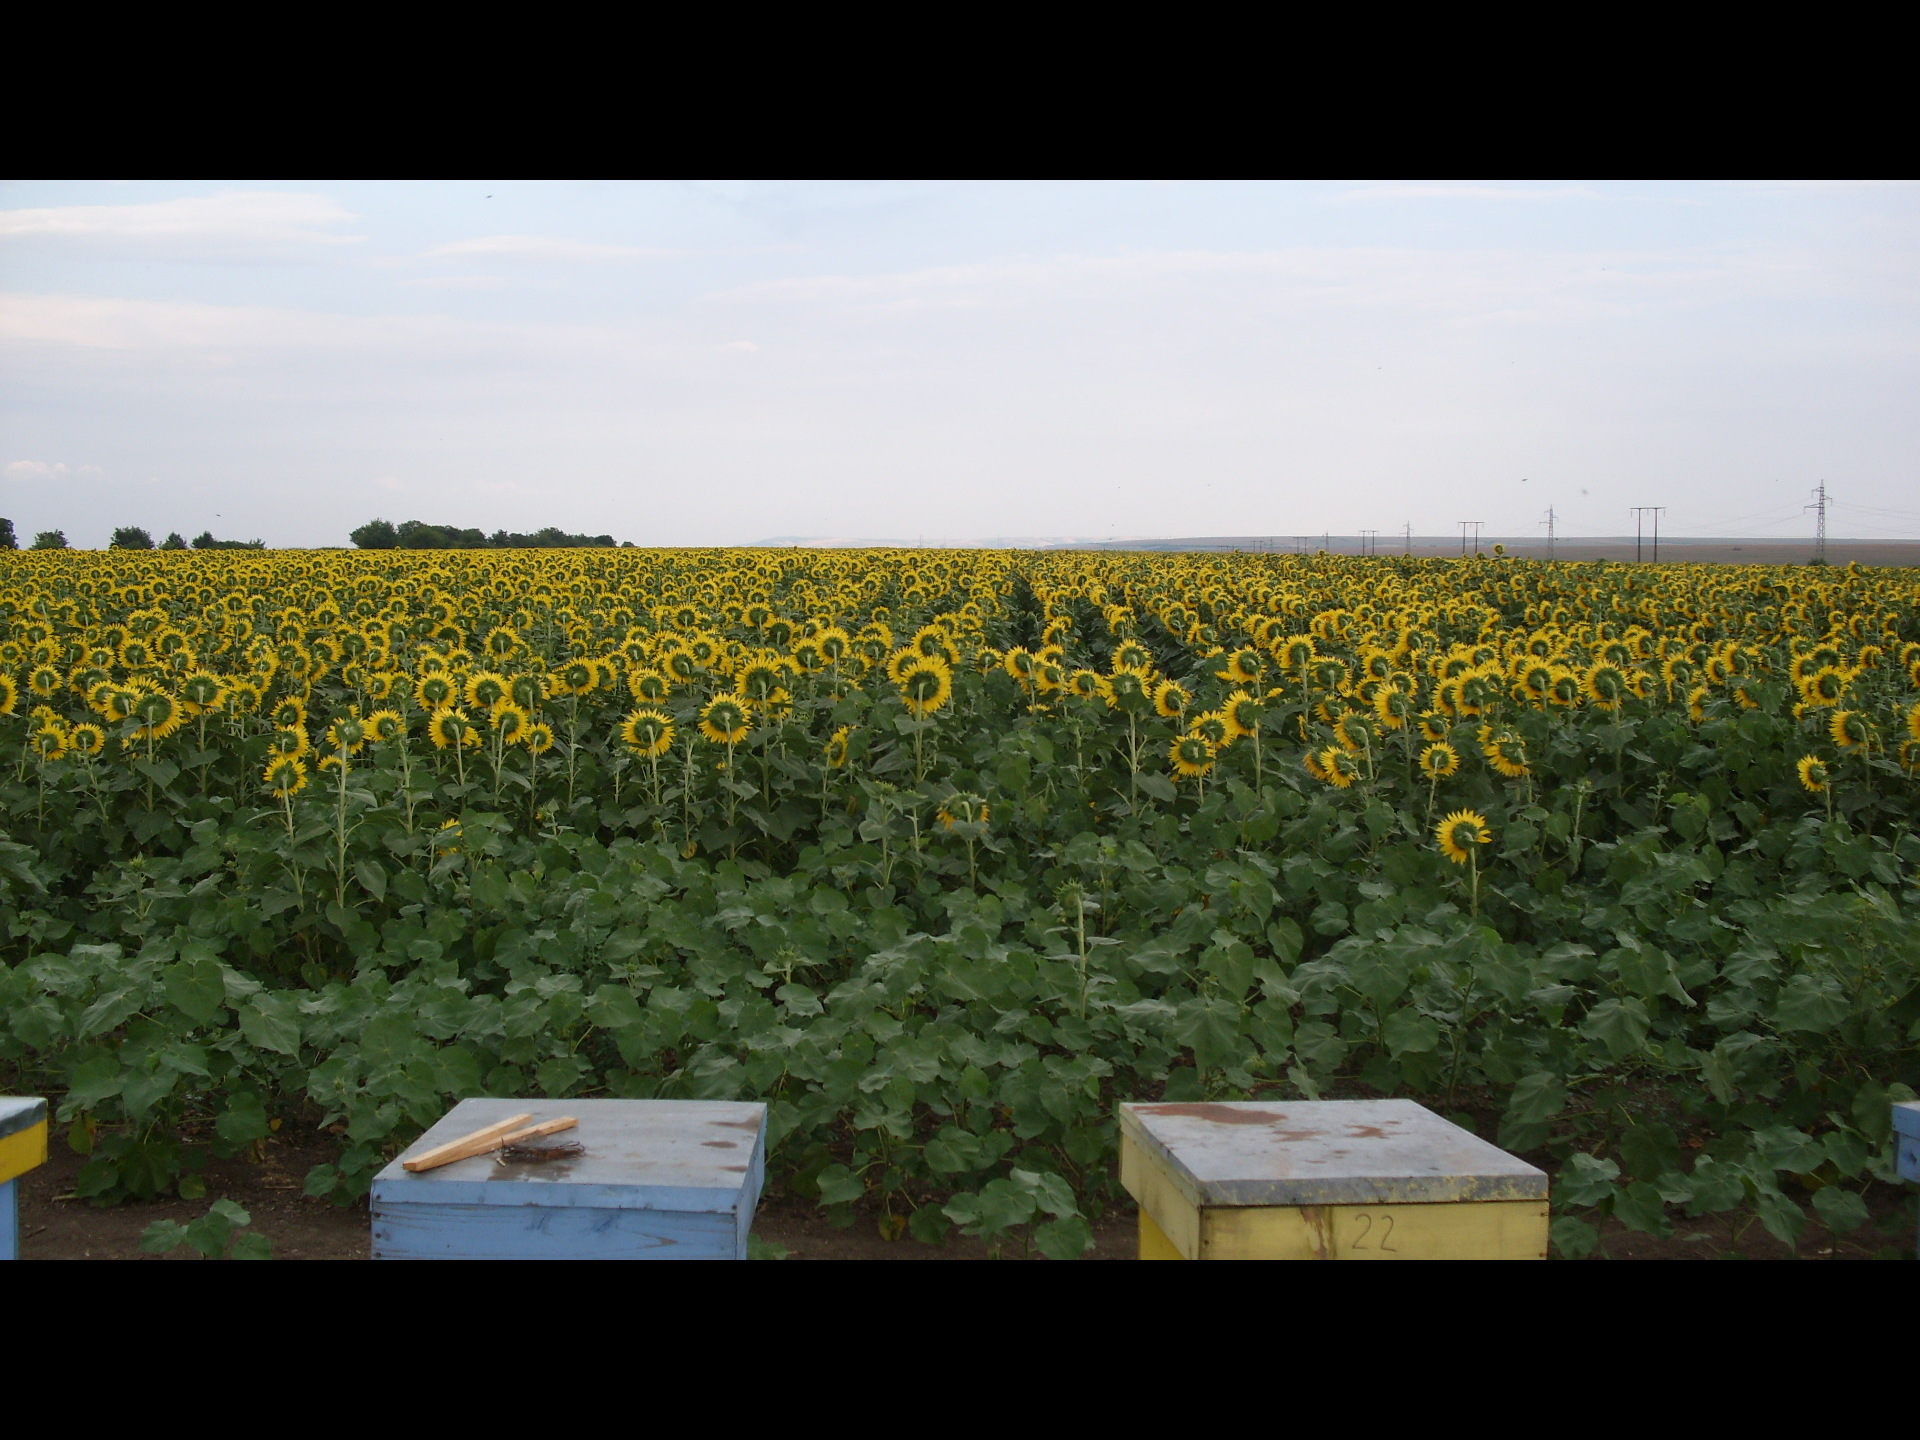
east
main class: Cropland
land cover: Sunflower
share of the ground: > 75 %
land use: Agriculture (excluding fallow land and kitchen gardens)
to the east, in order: Sunflower
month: July
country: BG
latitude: 43.7820
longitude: 23.5798
